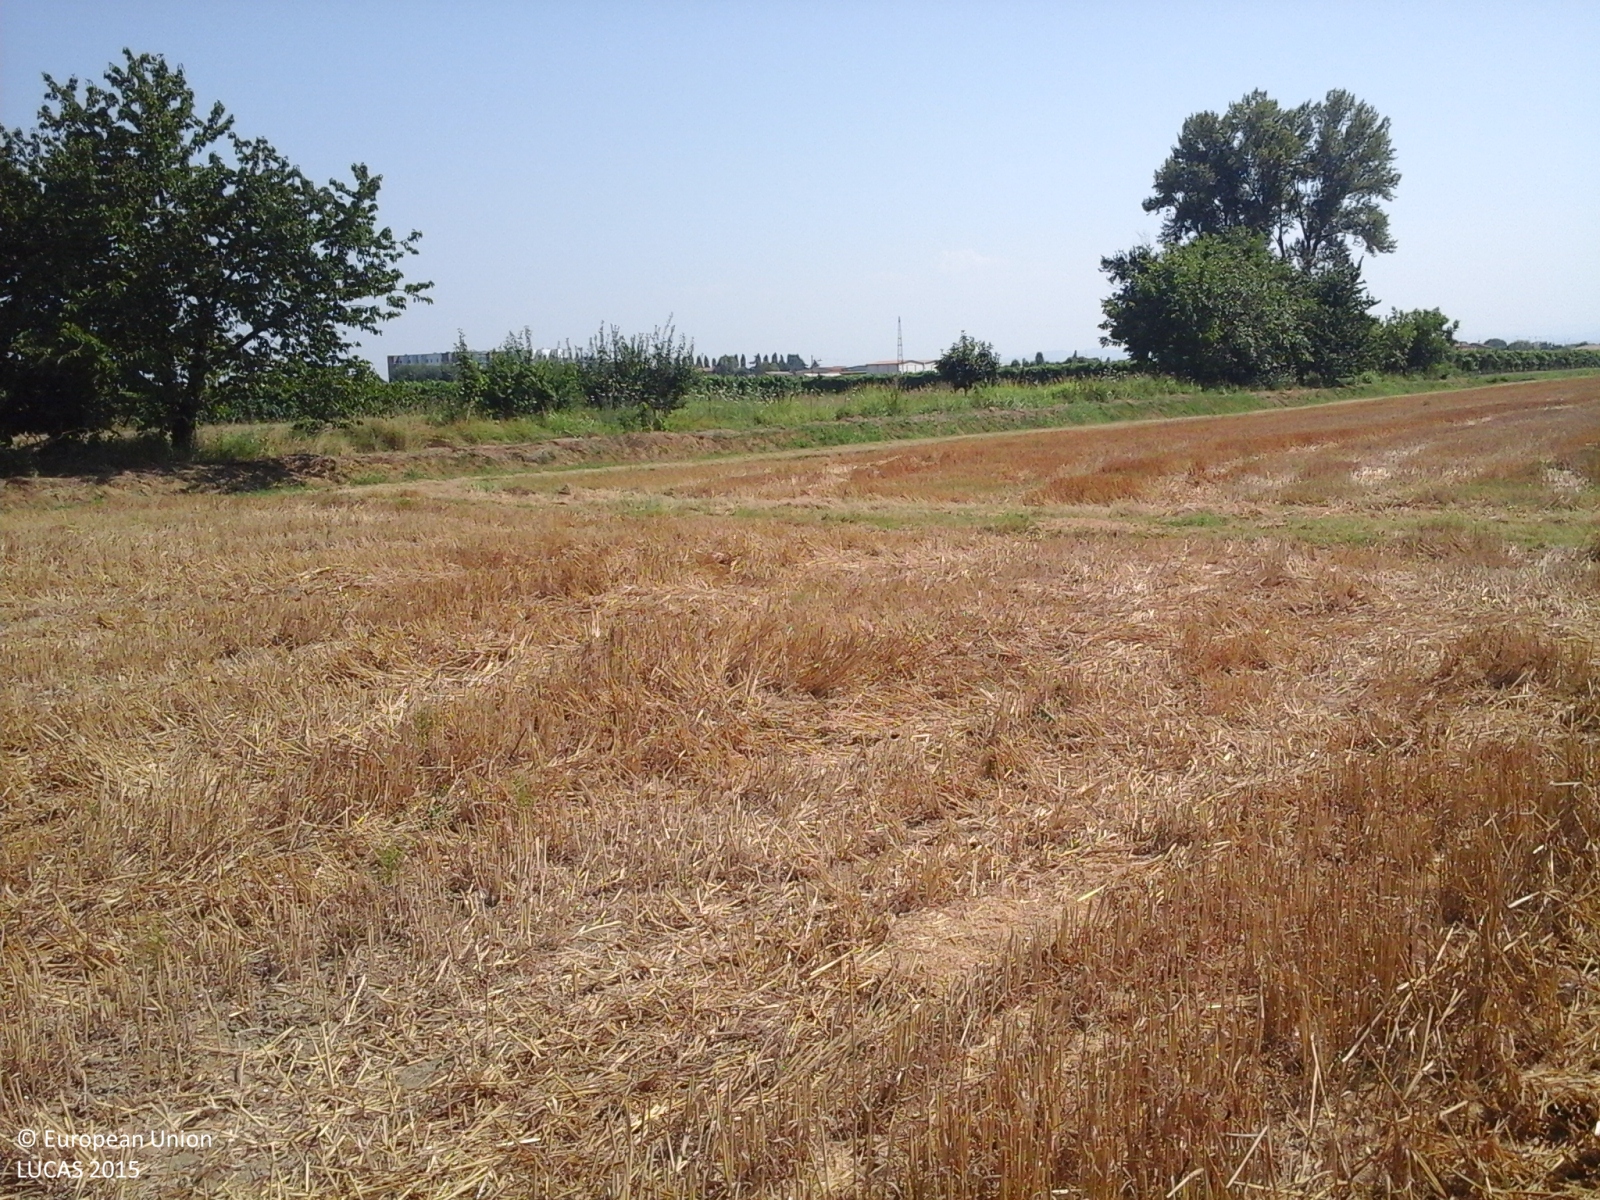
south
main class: Cropland
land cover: Common wheat
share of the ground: > 75 %
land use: Agriculture (excluding fallow land and kitchen gardens)
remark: Harvested field
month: July
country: IT
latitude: 44.4055
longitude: 11.8919
